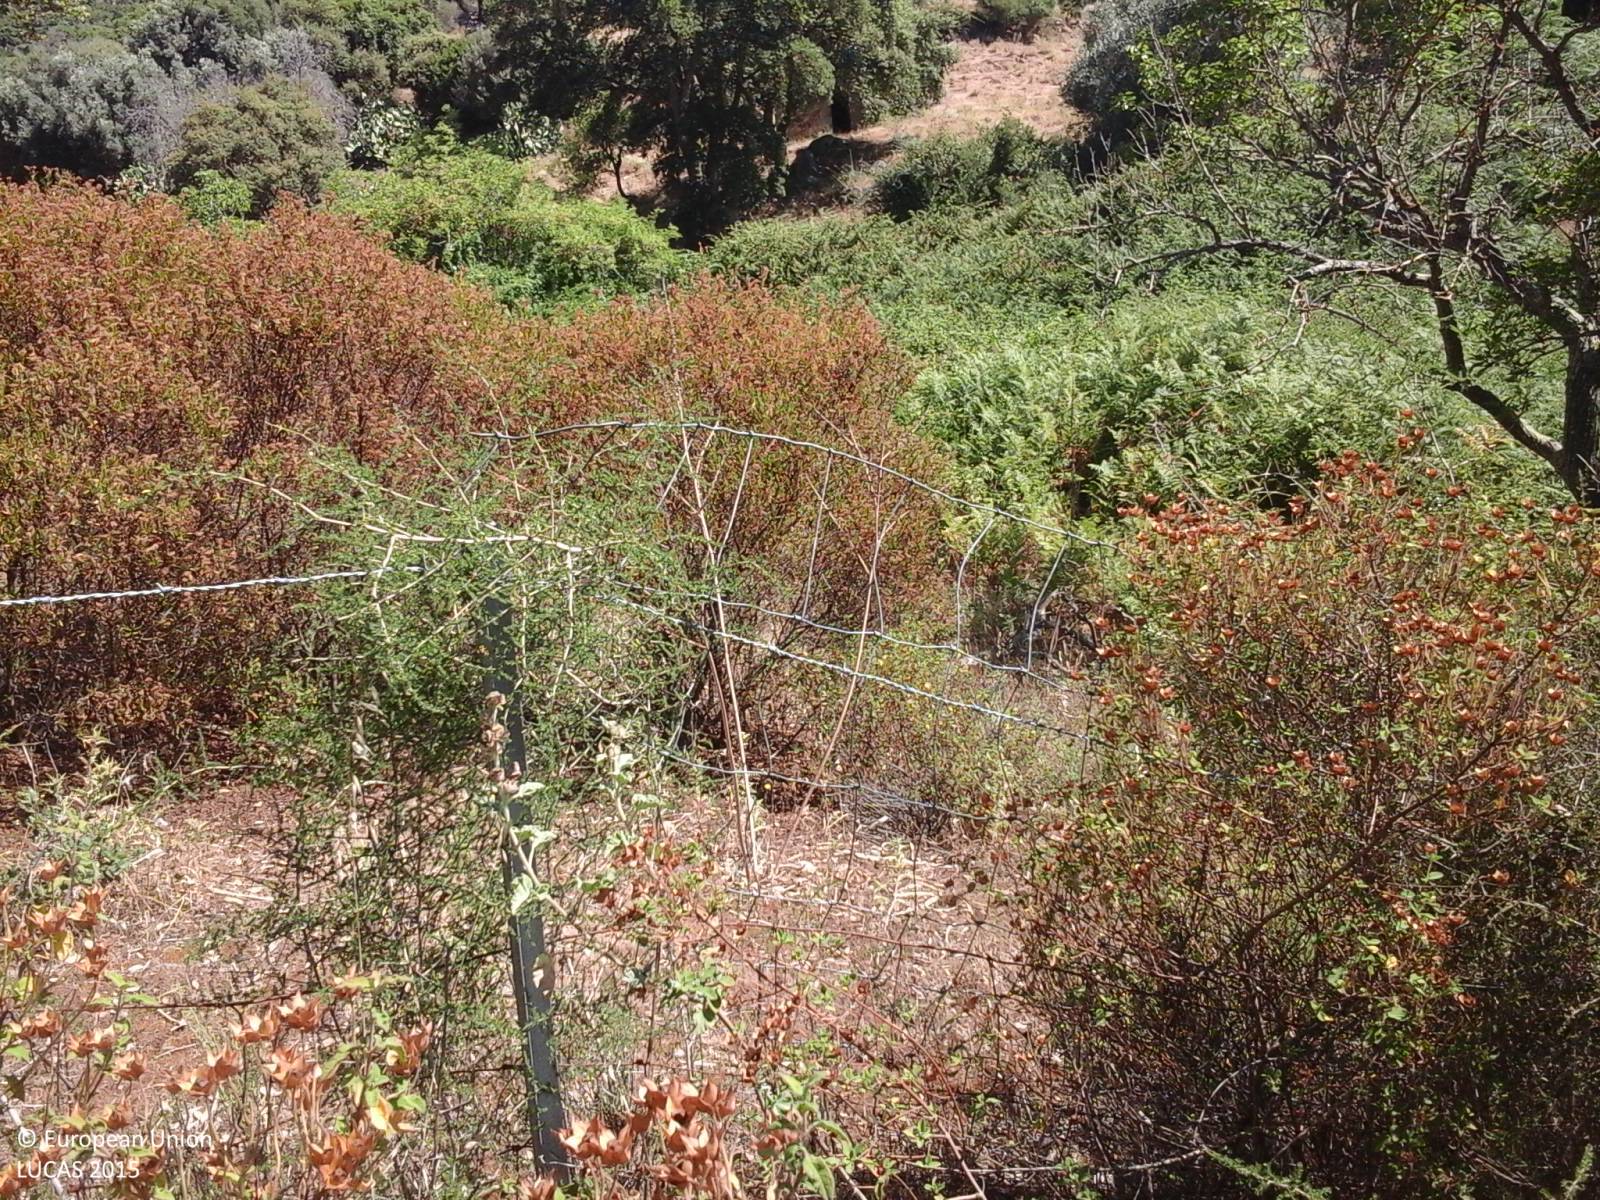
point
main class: Woodland
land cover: Broadleaved woodland
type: broadleaved evergreen forest
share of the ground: > 75 %
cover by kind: broadleaved forest trees 80 %, herbaceous plants 15 %, shrubs 5 %
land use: Semi-natural and natural areas not in use
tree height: > 5 m
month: July
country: IT
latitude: 39.5326
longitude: 8.5773
